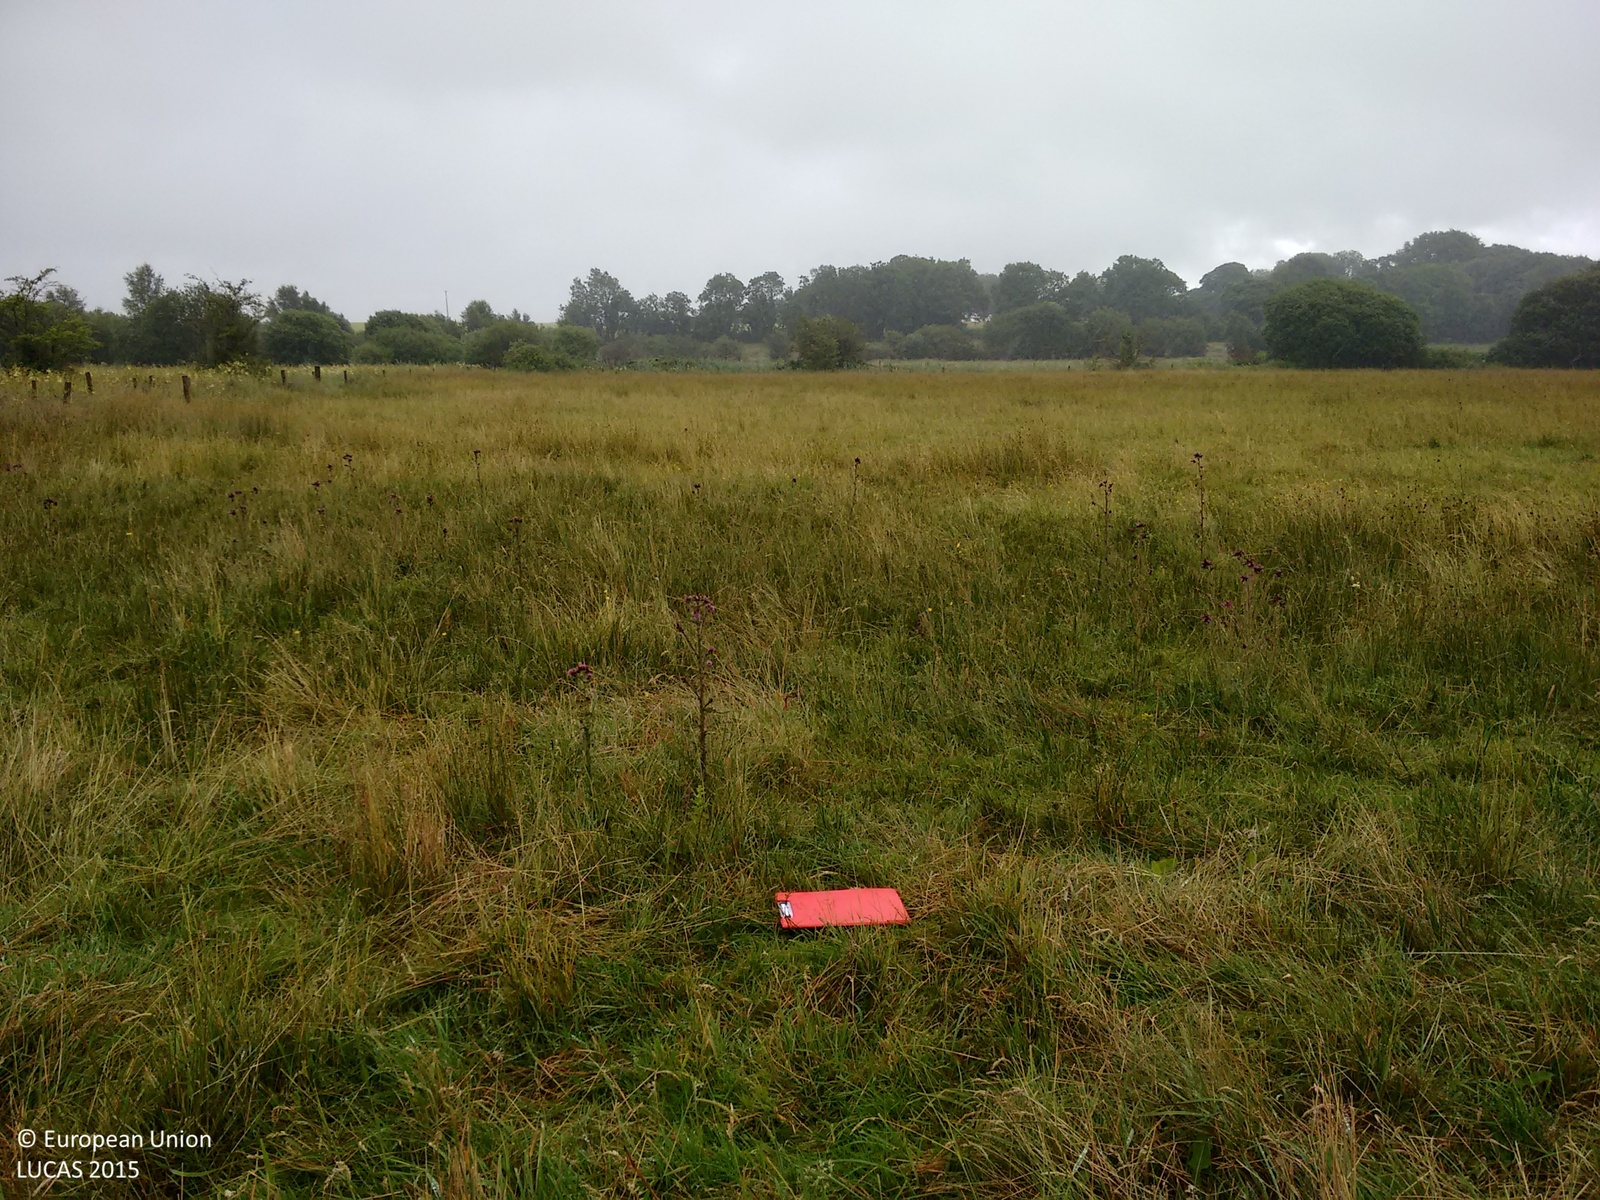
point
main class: Grassland
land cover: Grassland without tree/shrub cover
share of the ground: > 75 %
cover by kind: herbaceous plants 95 %, shrubs 5 %
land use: Agriculture (excluding fallow land and kitchen gardens)
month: July
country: IE
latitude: 53.6672
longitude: -7.8316
